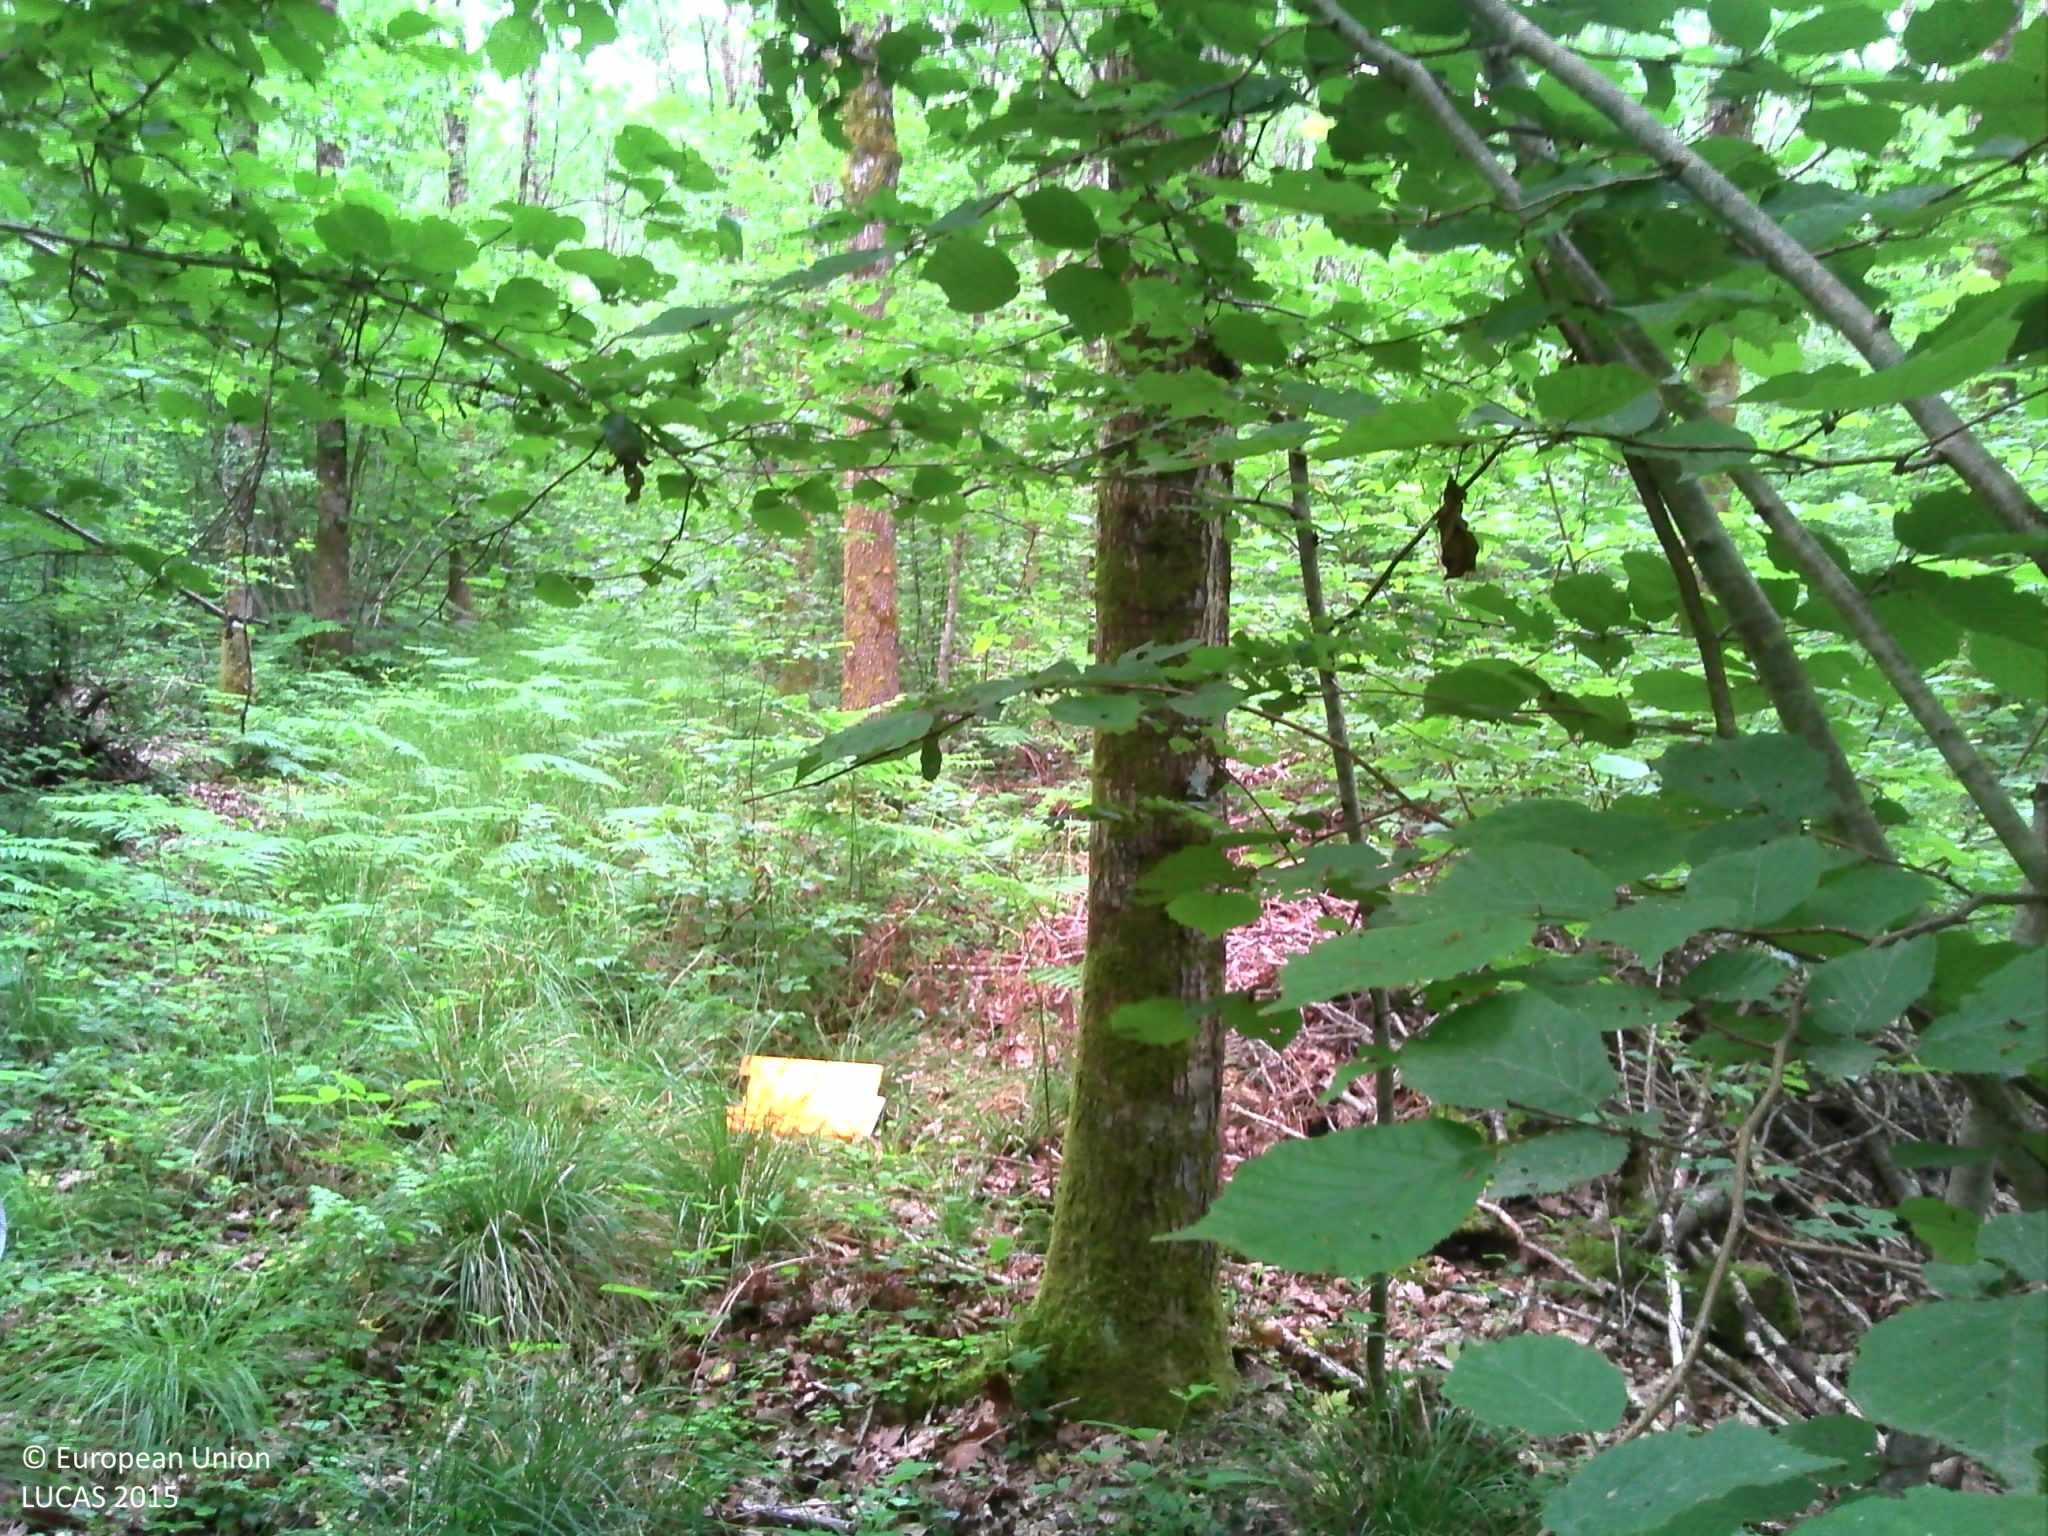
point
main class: Woodland
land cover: Broadleaved woodland
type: mesophytic deciduous forest
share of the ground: > 75 %
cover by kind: broadleaved forest trees 90 %, herbaceous plants 10 %
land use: Forestry
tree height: > 5 m
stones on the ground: < 10 %
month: June
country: FR
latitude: 47.8004
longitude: 6.2761
